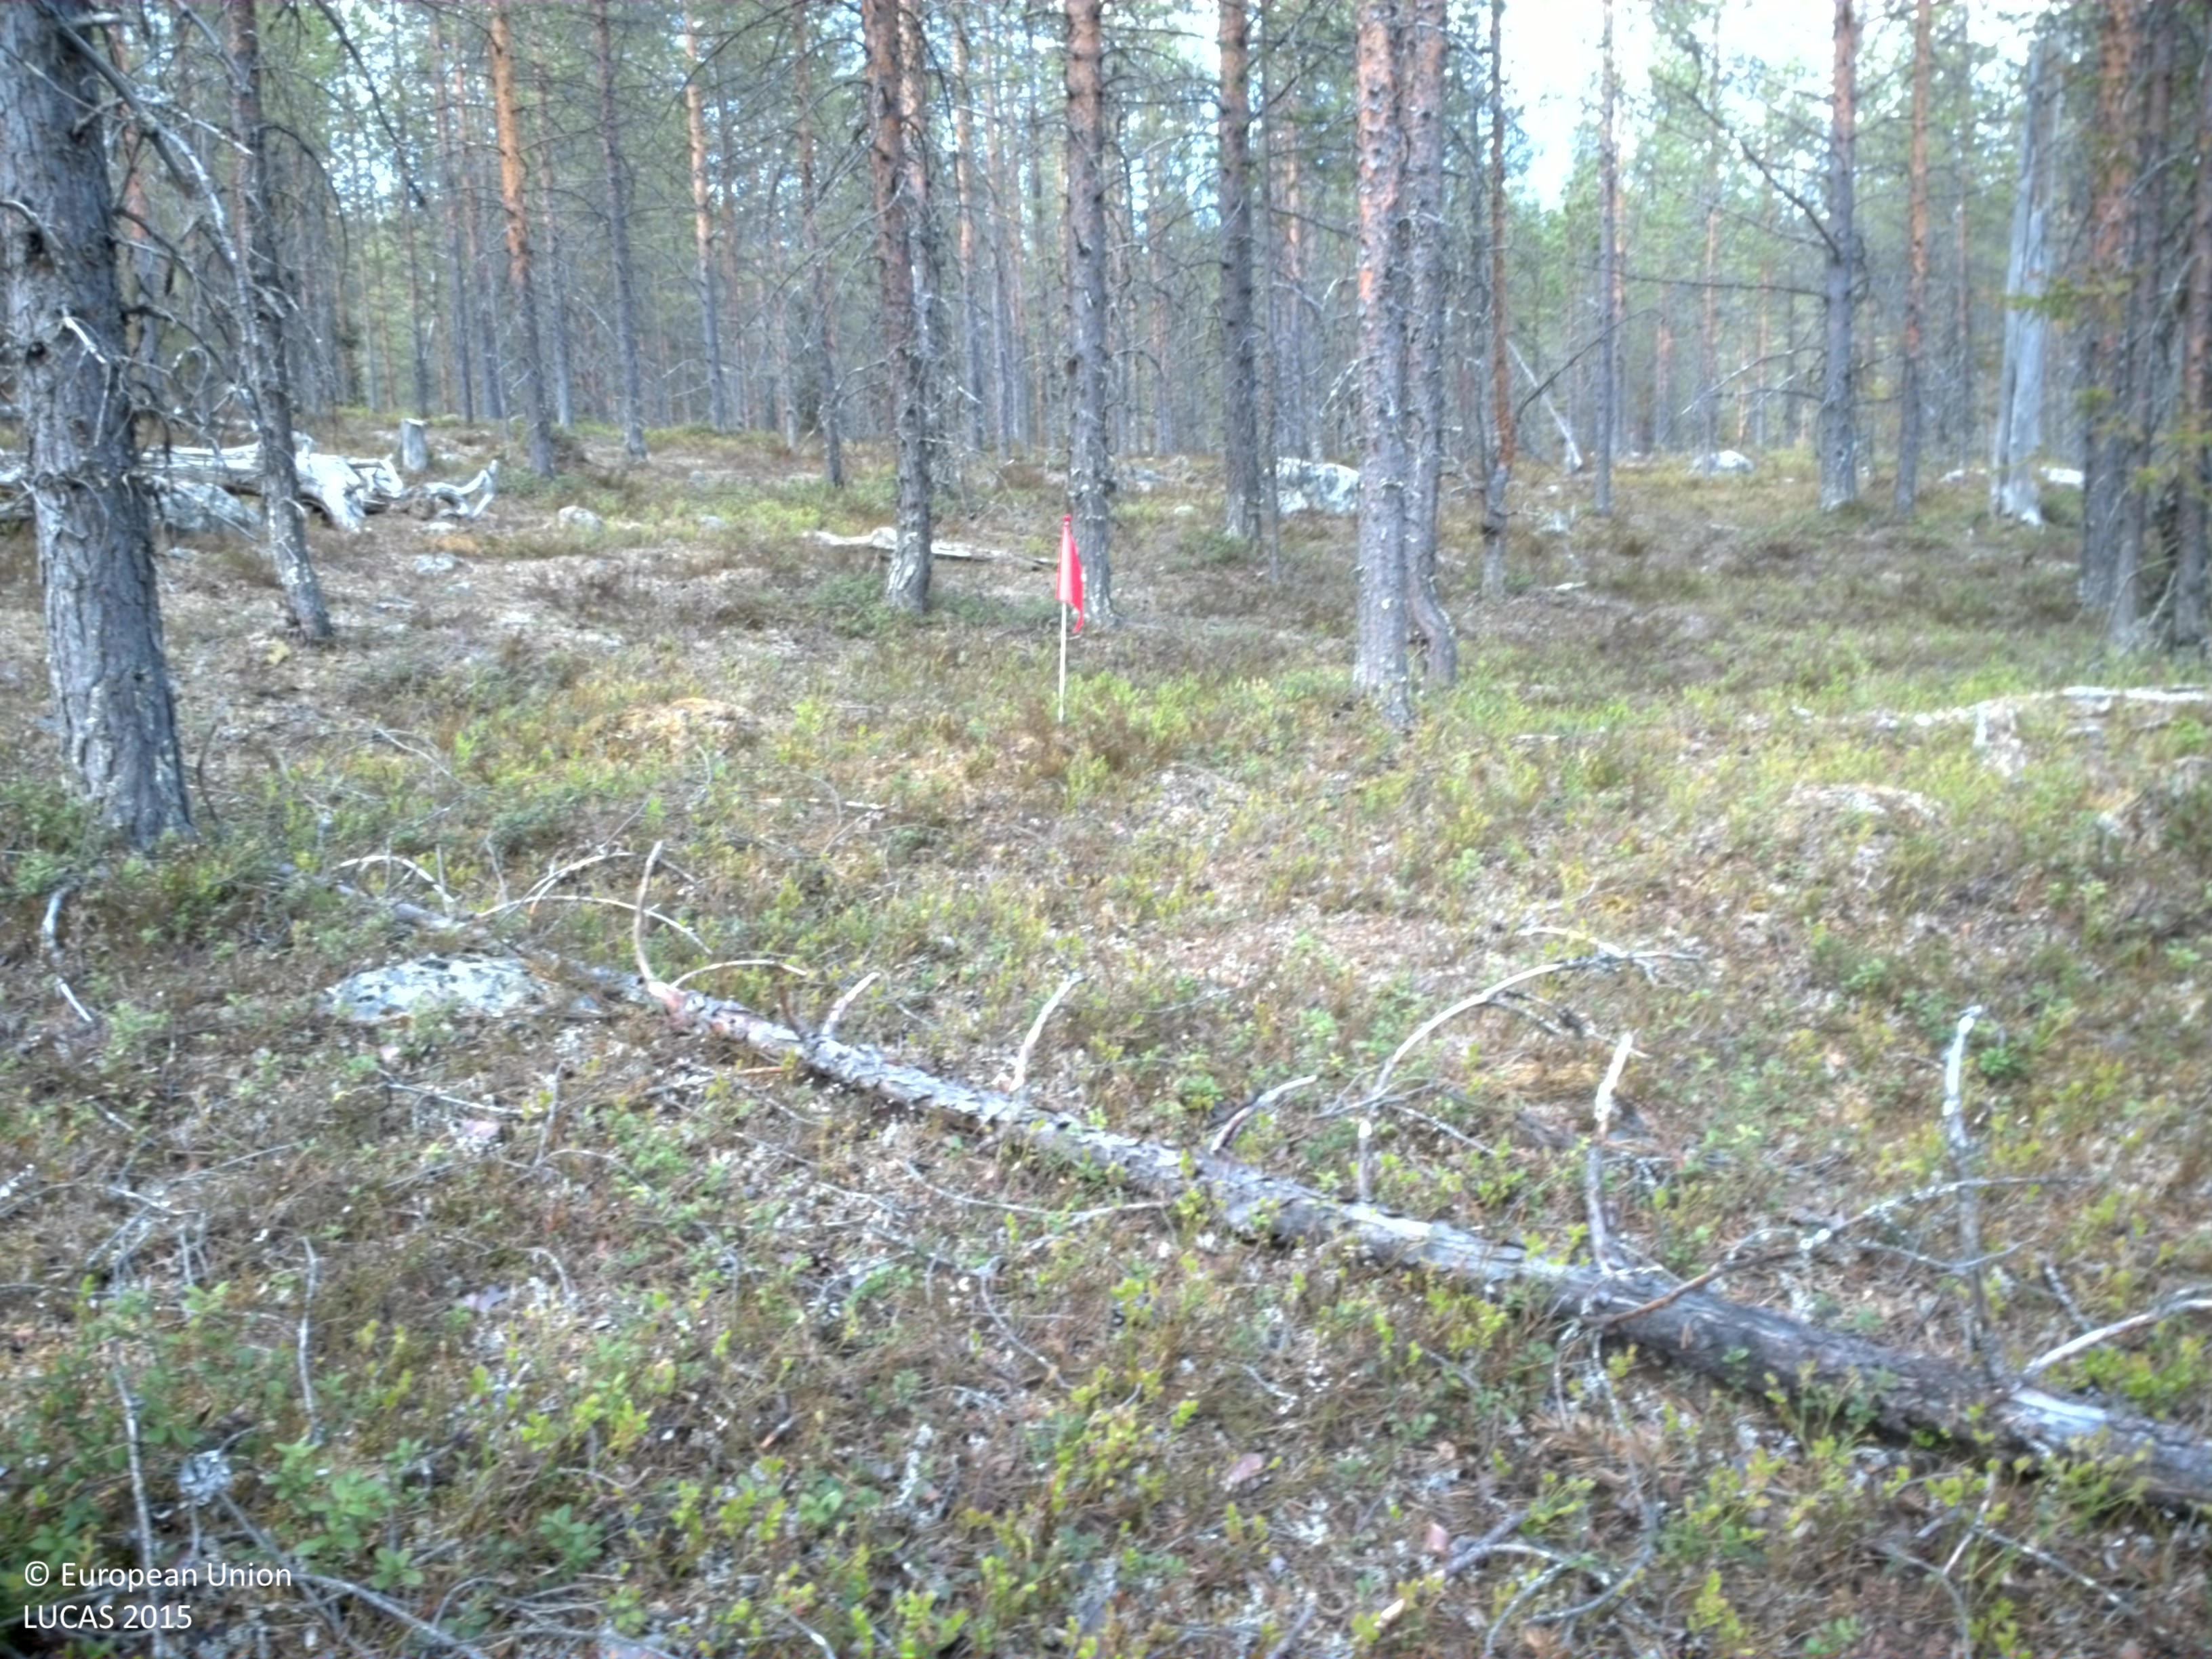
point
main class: Woodland
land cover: Pine dominated coniferous woodland
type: boreal forest
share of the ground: 25 - 50 %
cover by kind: shrubs 50 %, coniferous forest trees 40 %, lichens and mosses 5 %, consolidated bare surface 5 %
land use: Forestry
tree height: > 5 m
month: June
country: SE
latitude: 65.8988
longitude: 19.5052
